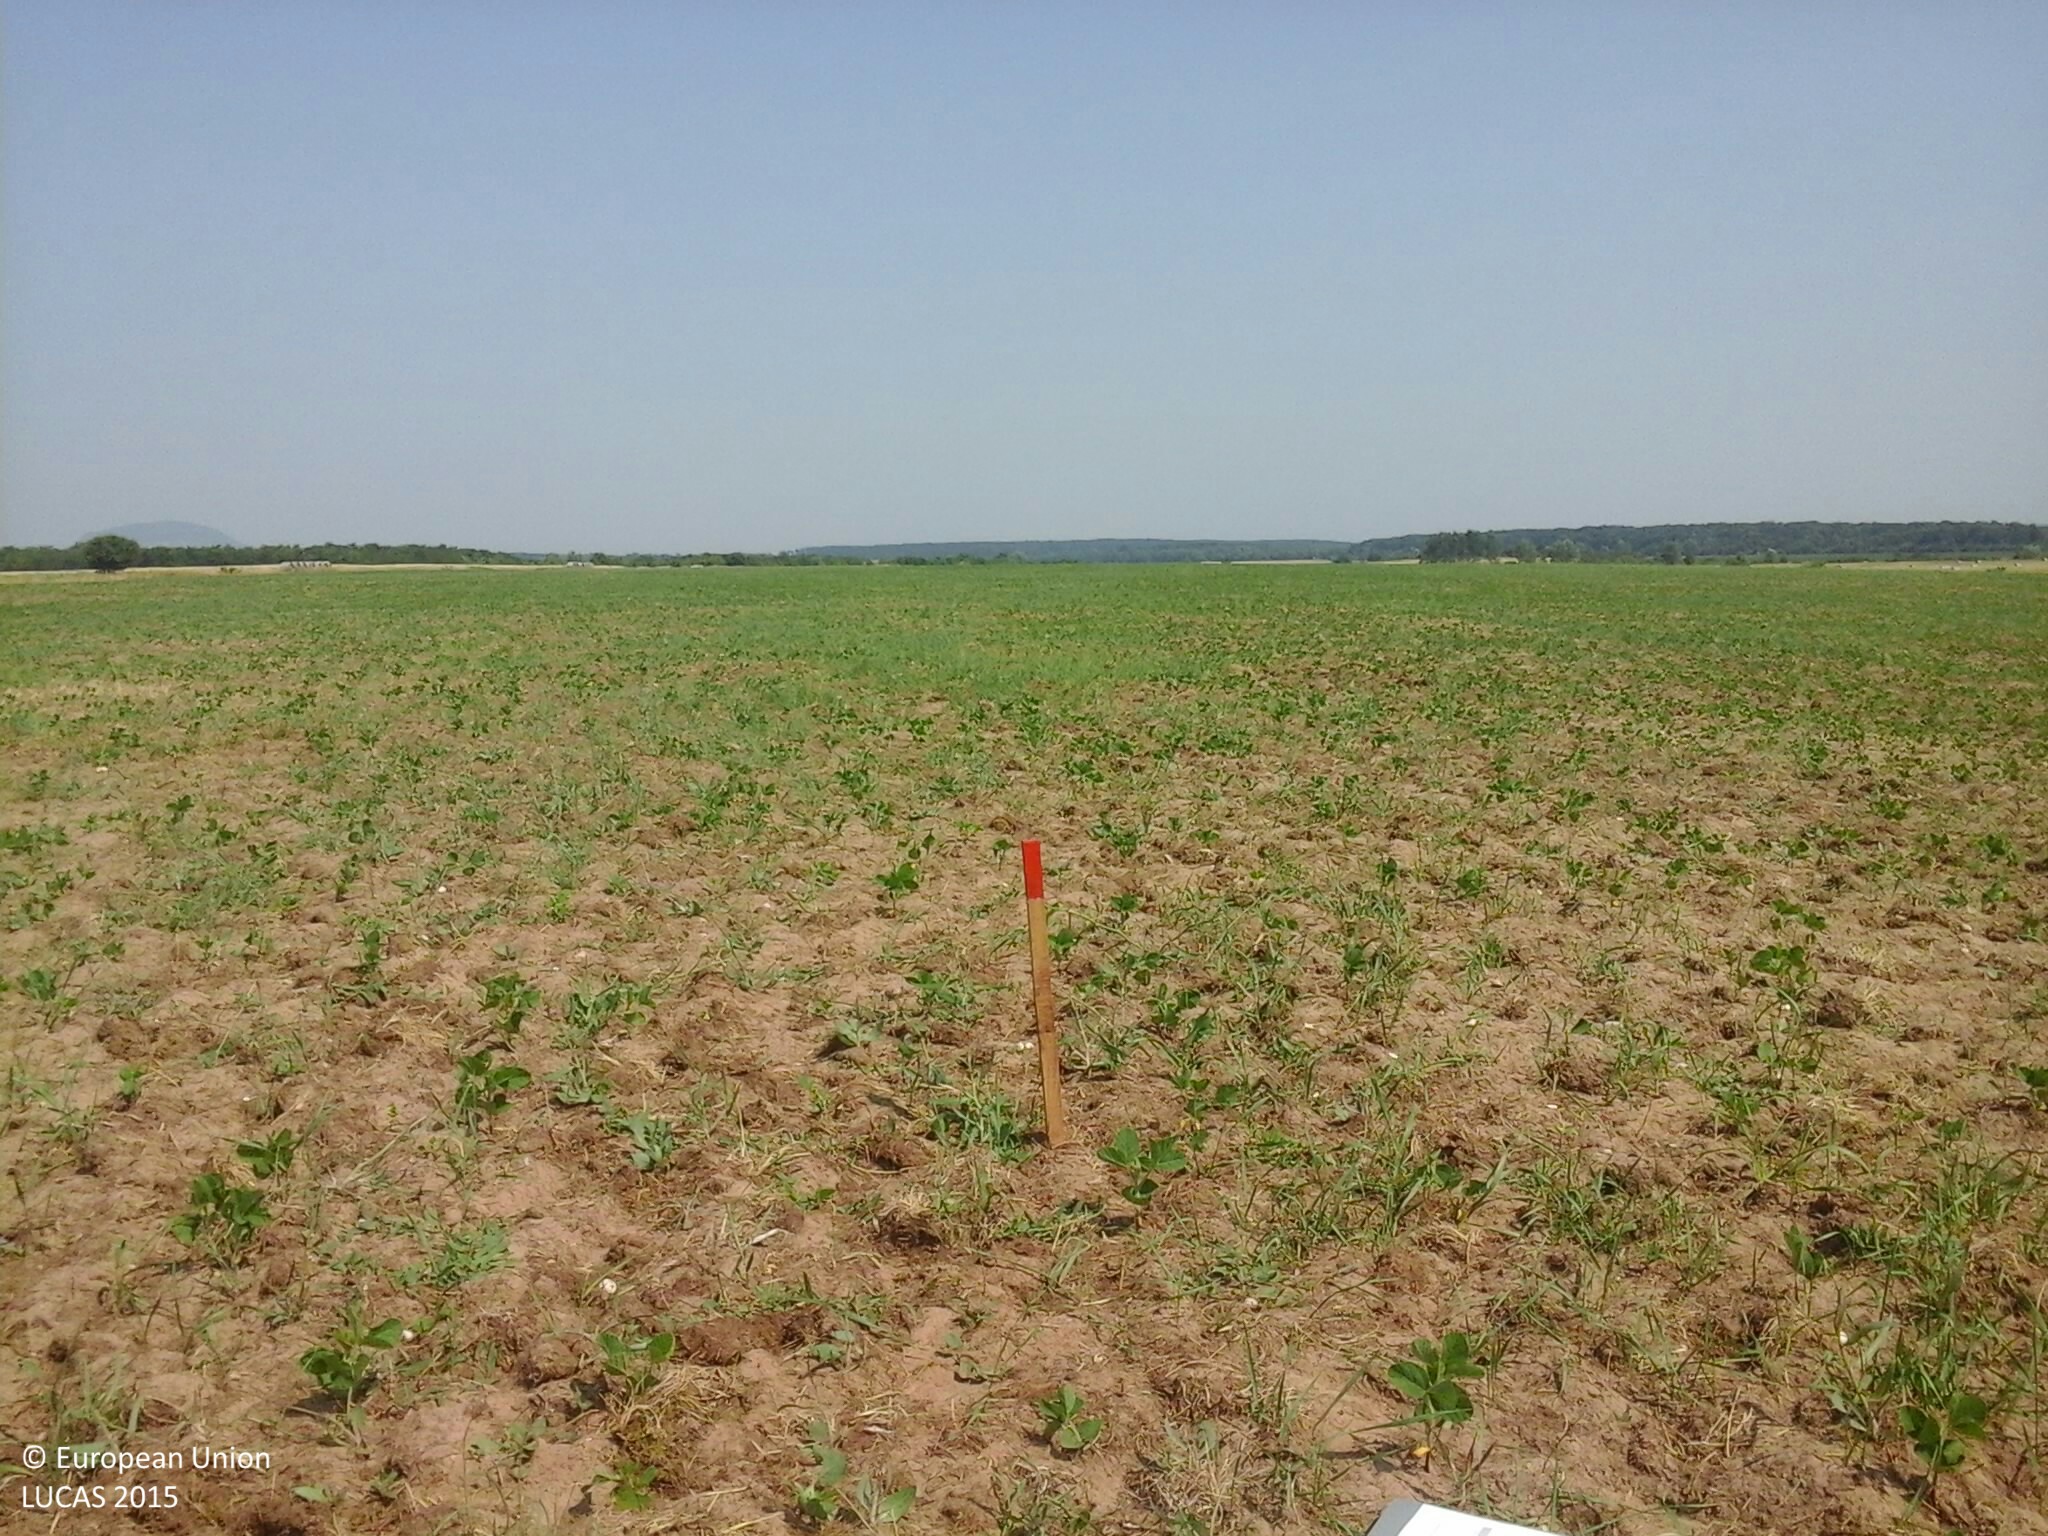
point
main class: Cropland
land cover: Soya
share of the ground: 10 - 25 %
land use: Agriculture (excluding fallow land and kitchen gardens)
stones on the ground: < 10 %
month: July
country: HU
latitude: 47.0481
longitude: 17.4699
